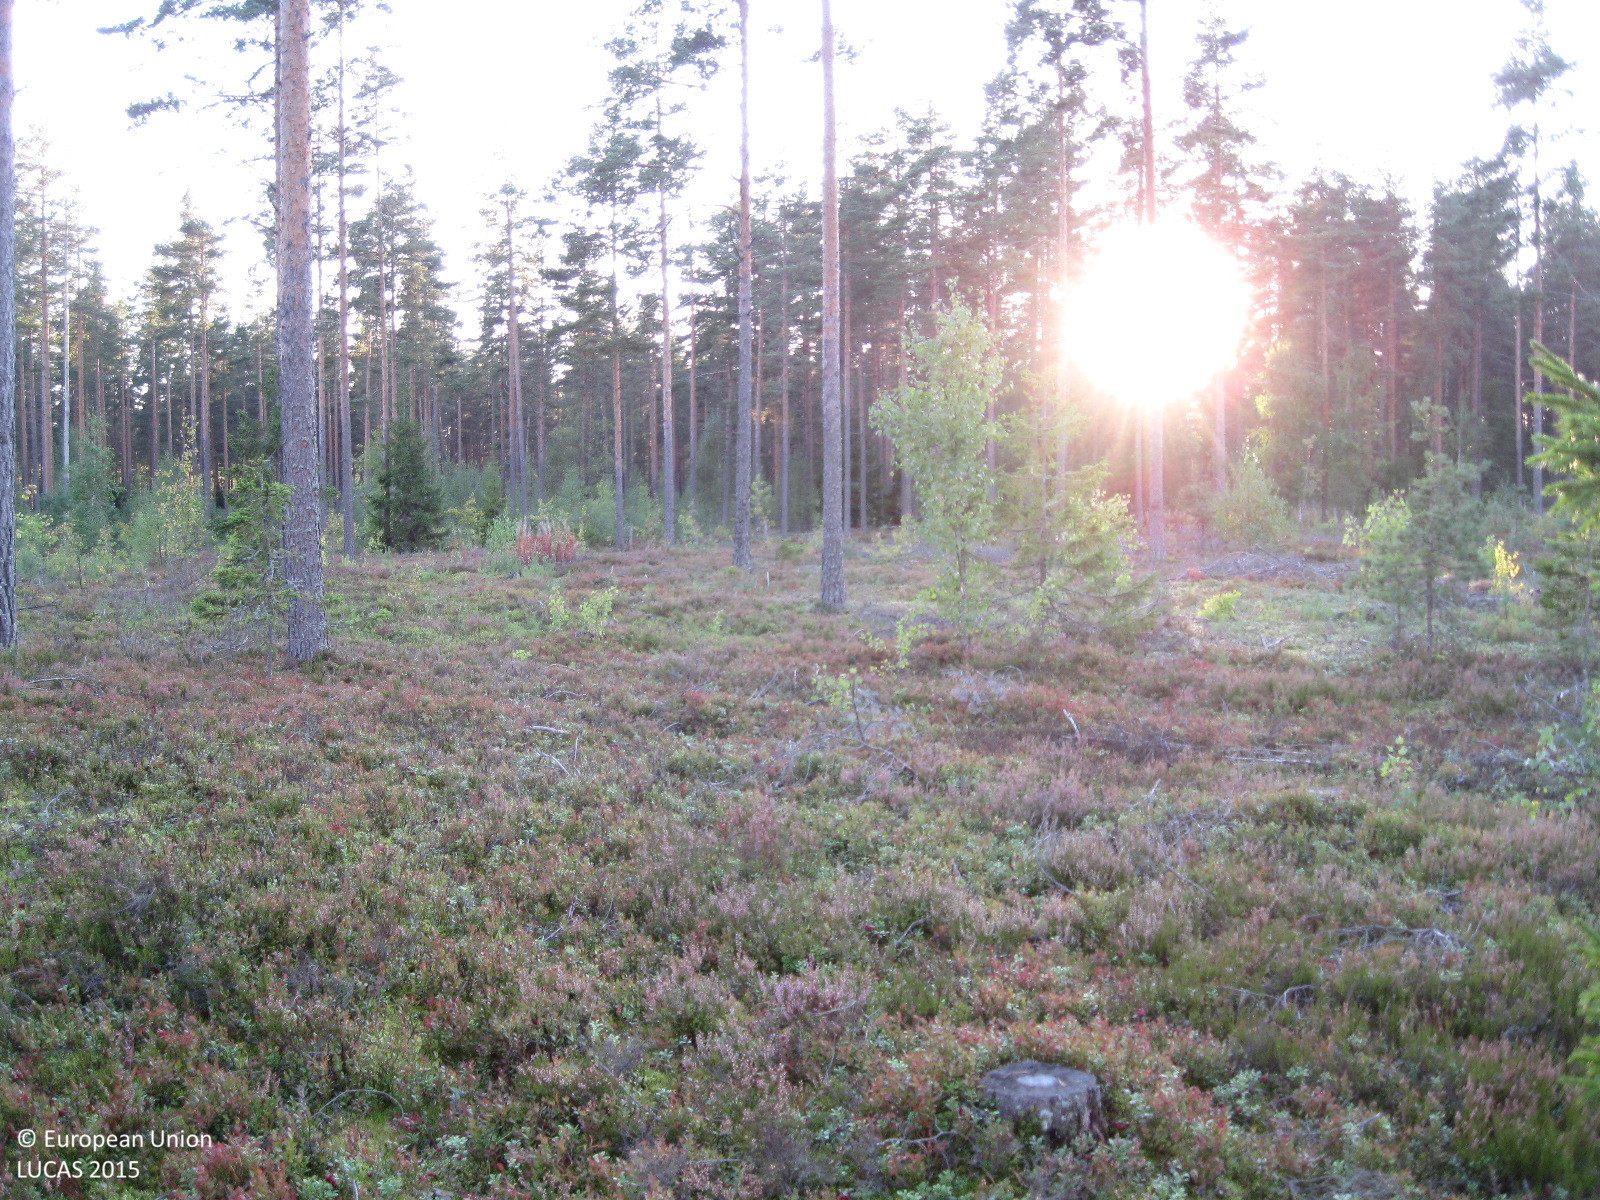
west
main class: Woodland
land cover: Pine dominated coniferous woodland
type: boreal forest
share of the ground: 25 - 50 %
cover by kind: shrubs 45 %, coniferous forest trees 25 %, lichens and mosses 25 %, broadleaved forest trees 5 %
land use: Forestry
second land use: Amenities, museums, leisure
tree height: > 5 m
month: September
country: FI
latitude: 60.5066
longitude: 24.6961
